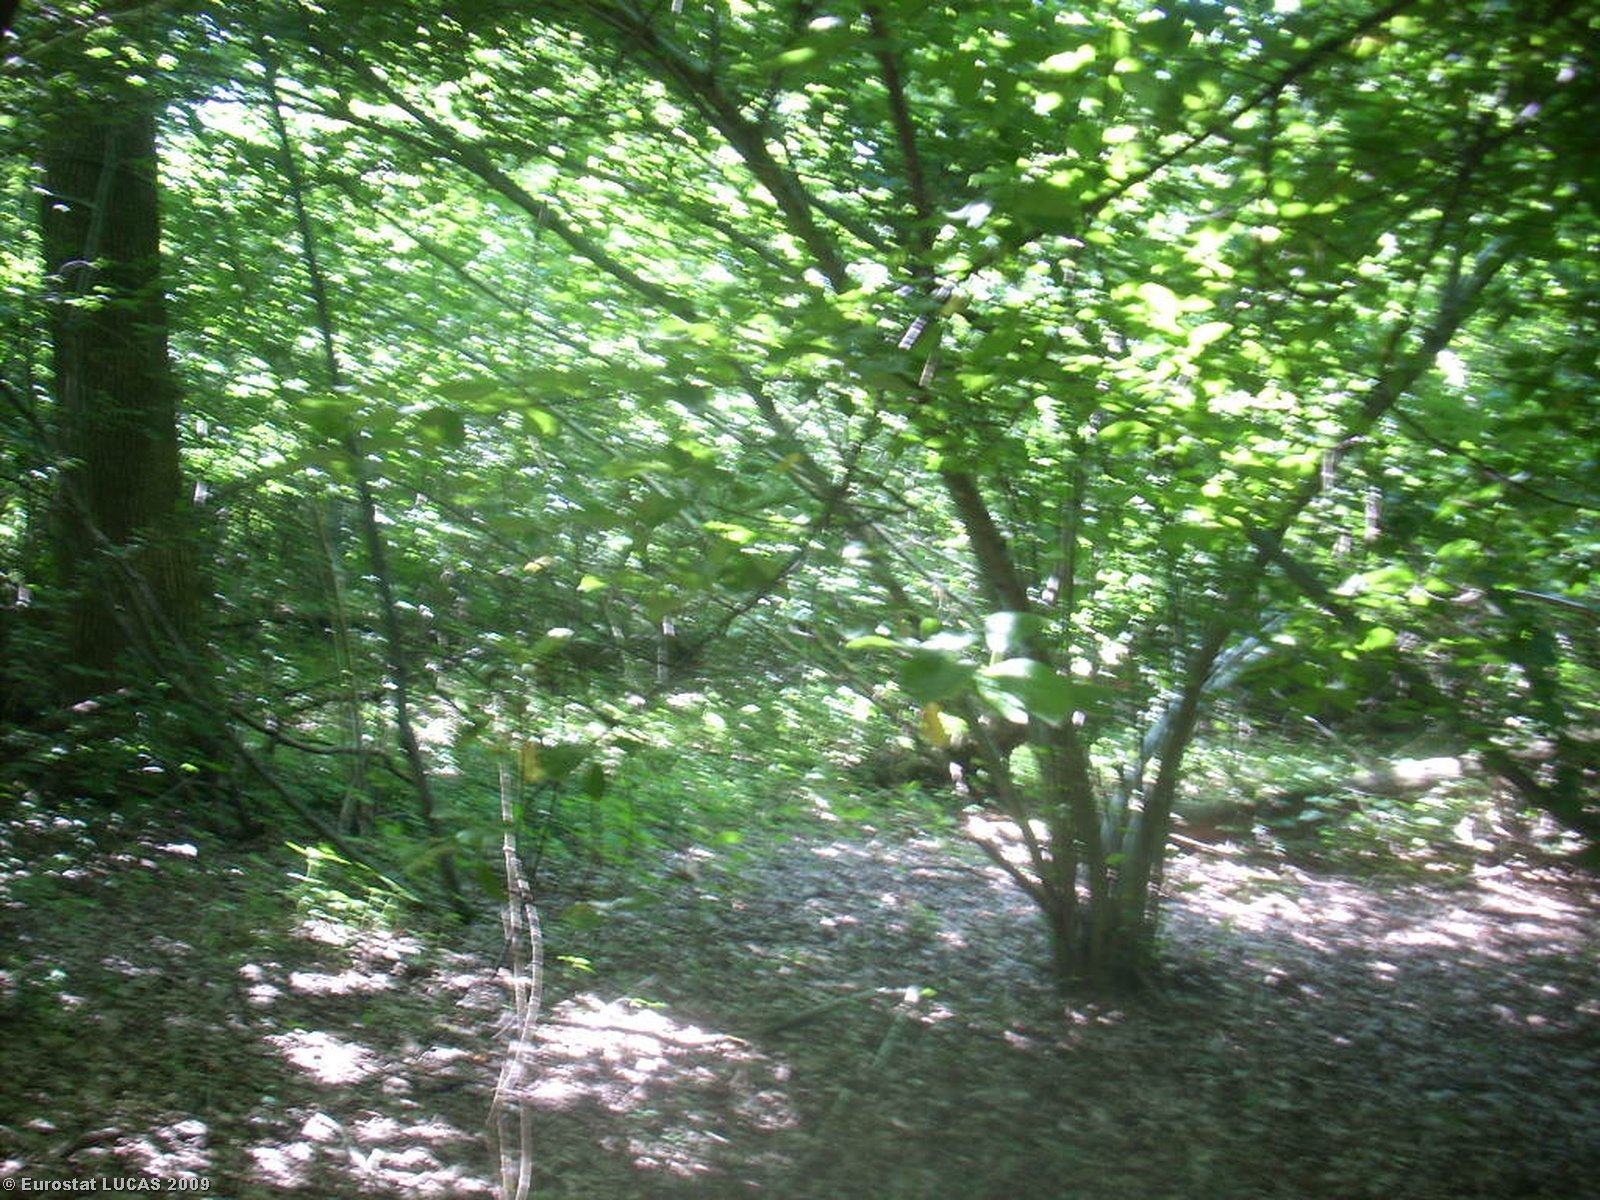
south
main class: Woodland
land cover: Broadleaved woodland
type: acidophilous oak and oak-birch forest
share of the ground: > 75 %
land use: Forestry
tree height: > 5 m
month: May
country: IT
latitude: 44.7154
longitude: 7.4171
